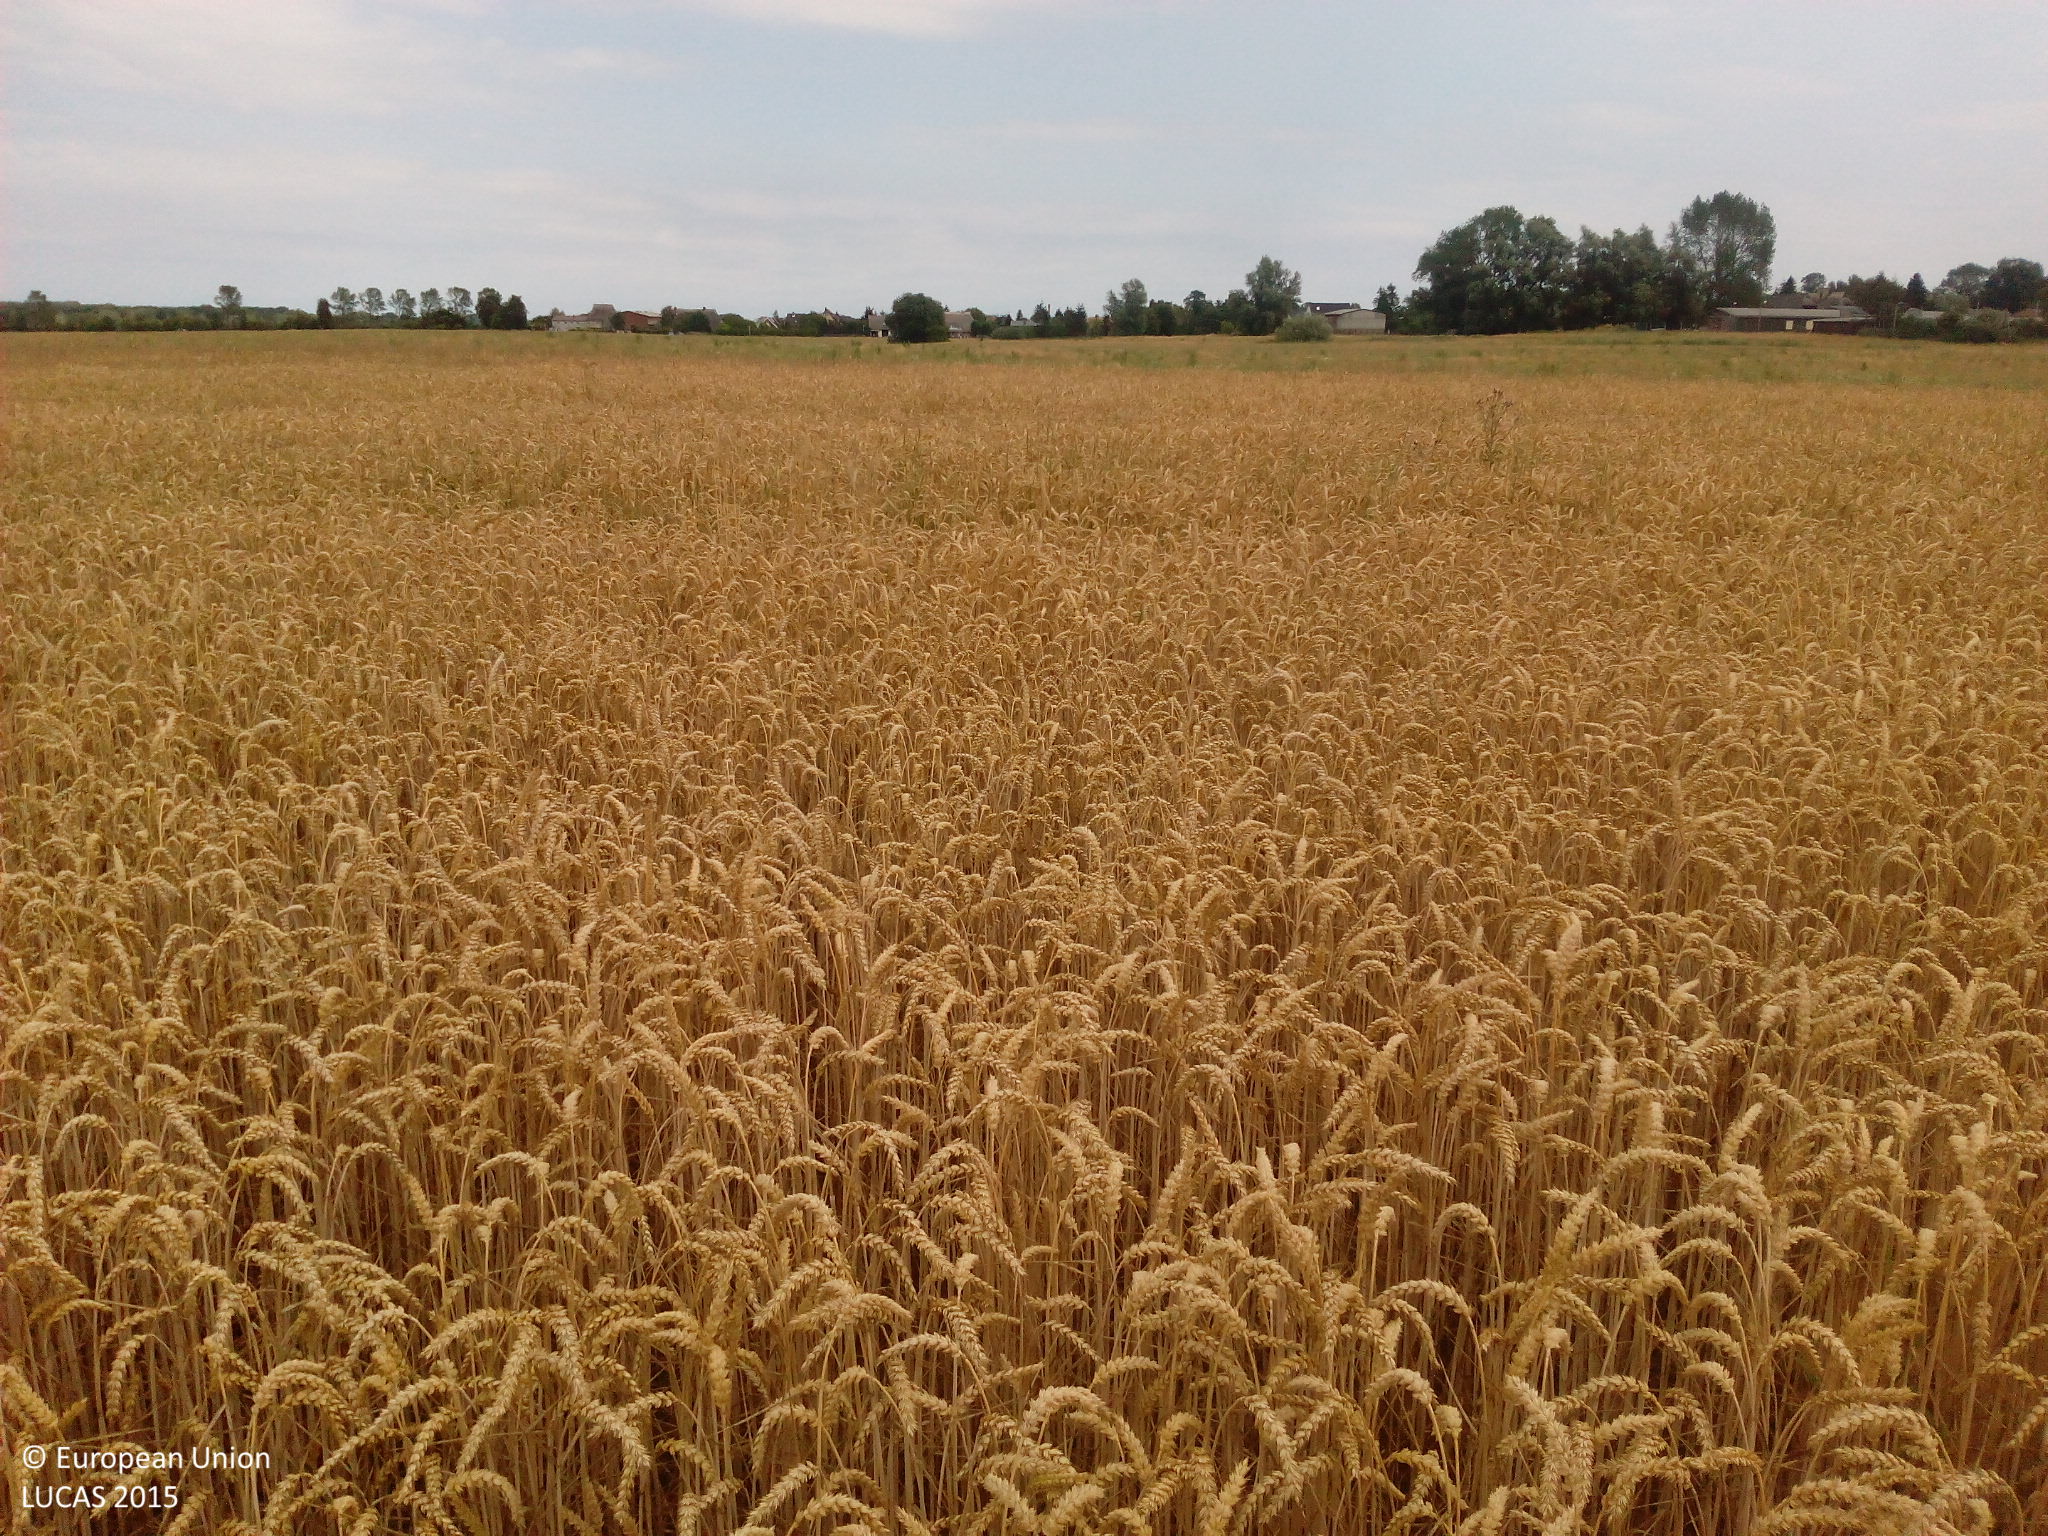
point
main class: Cropland
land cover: Common wheat
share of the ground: > 75 %
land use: Agriculture (excluding fallow land and kitchen gardens)
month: July
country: DE
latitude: 54.2423
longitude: 12.3468
